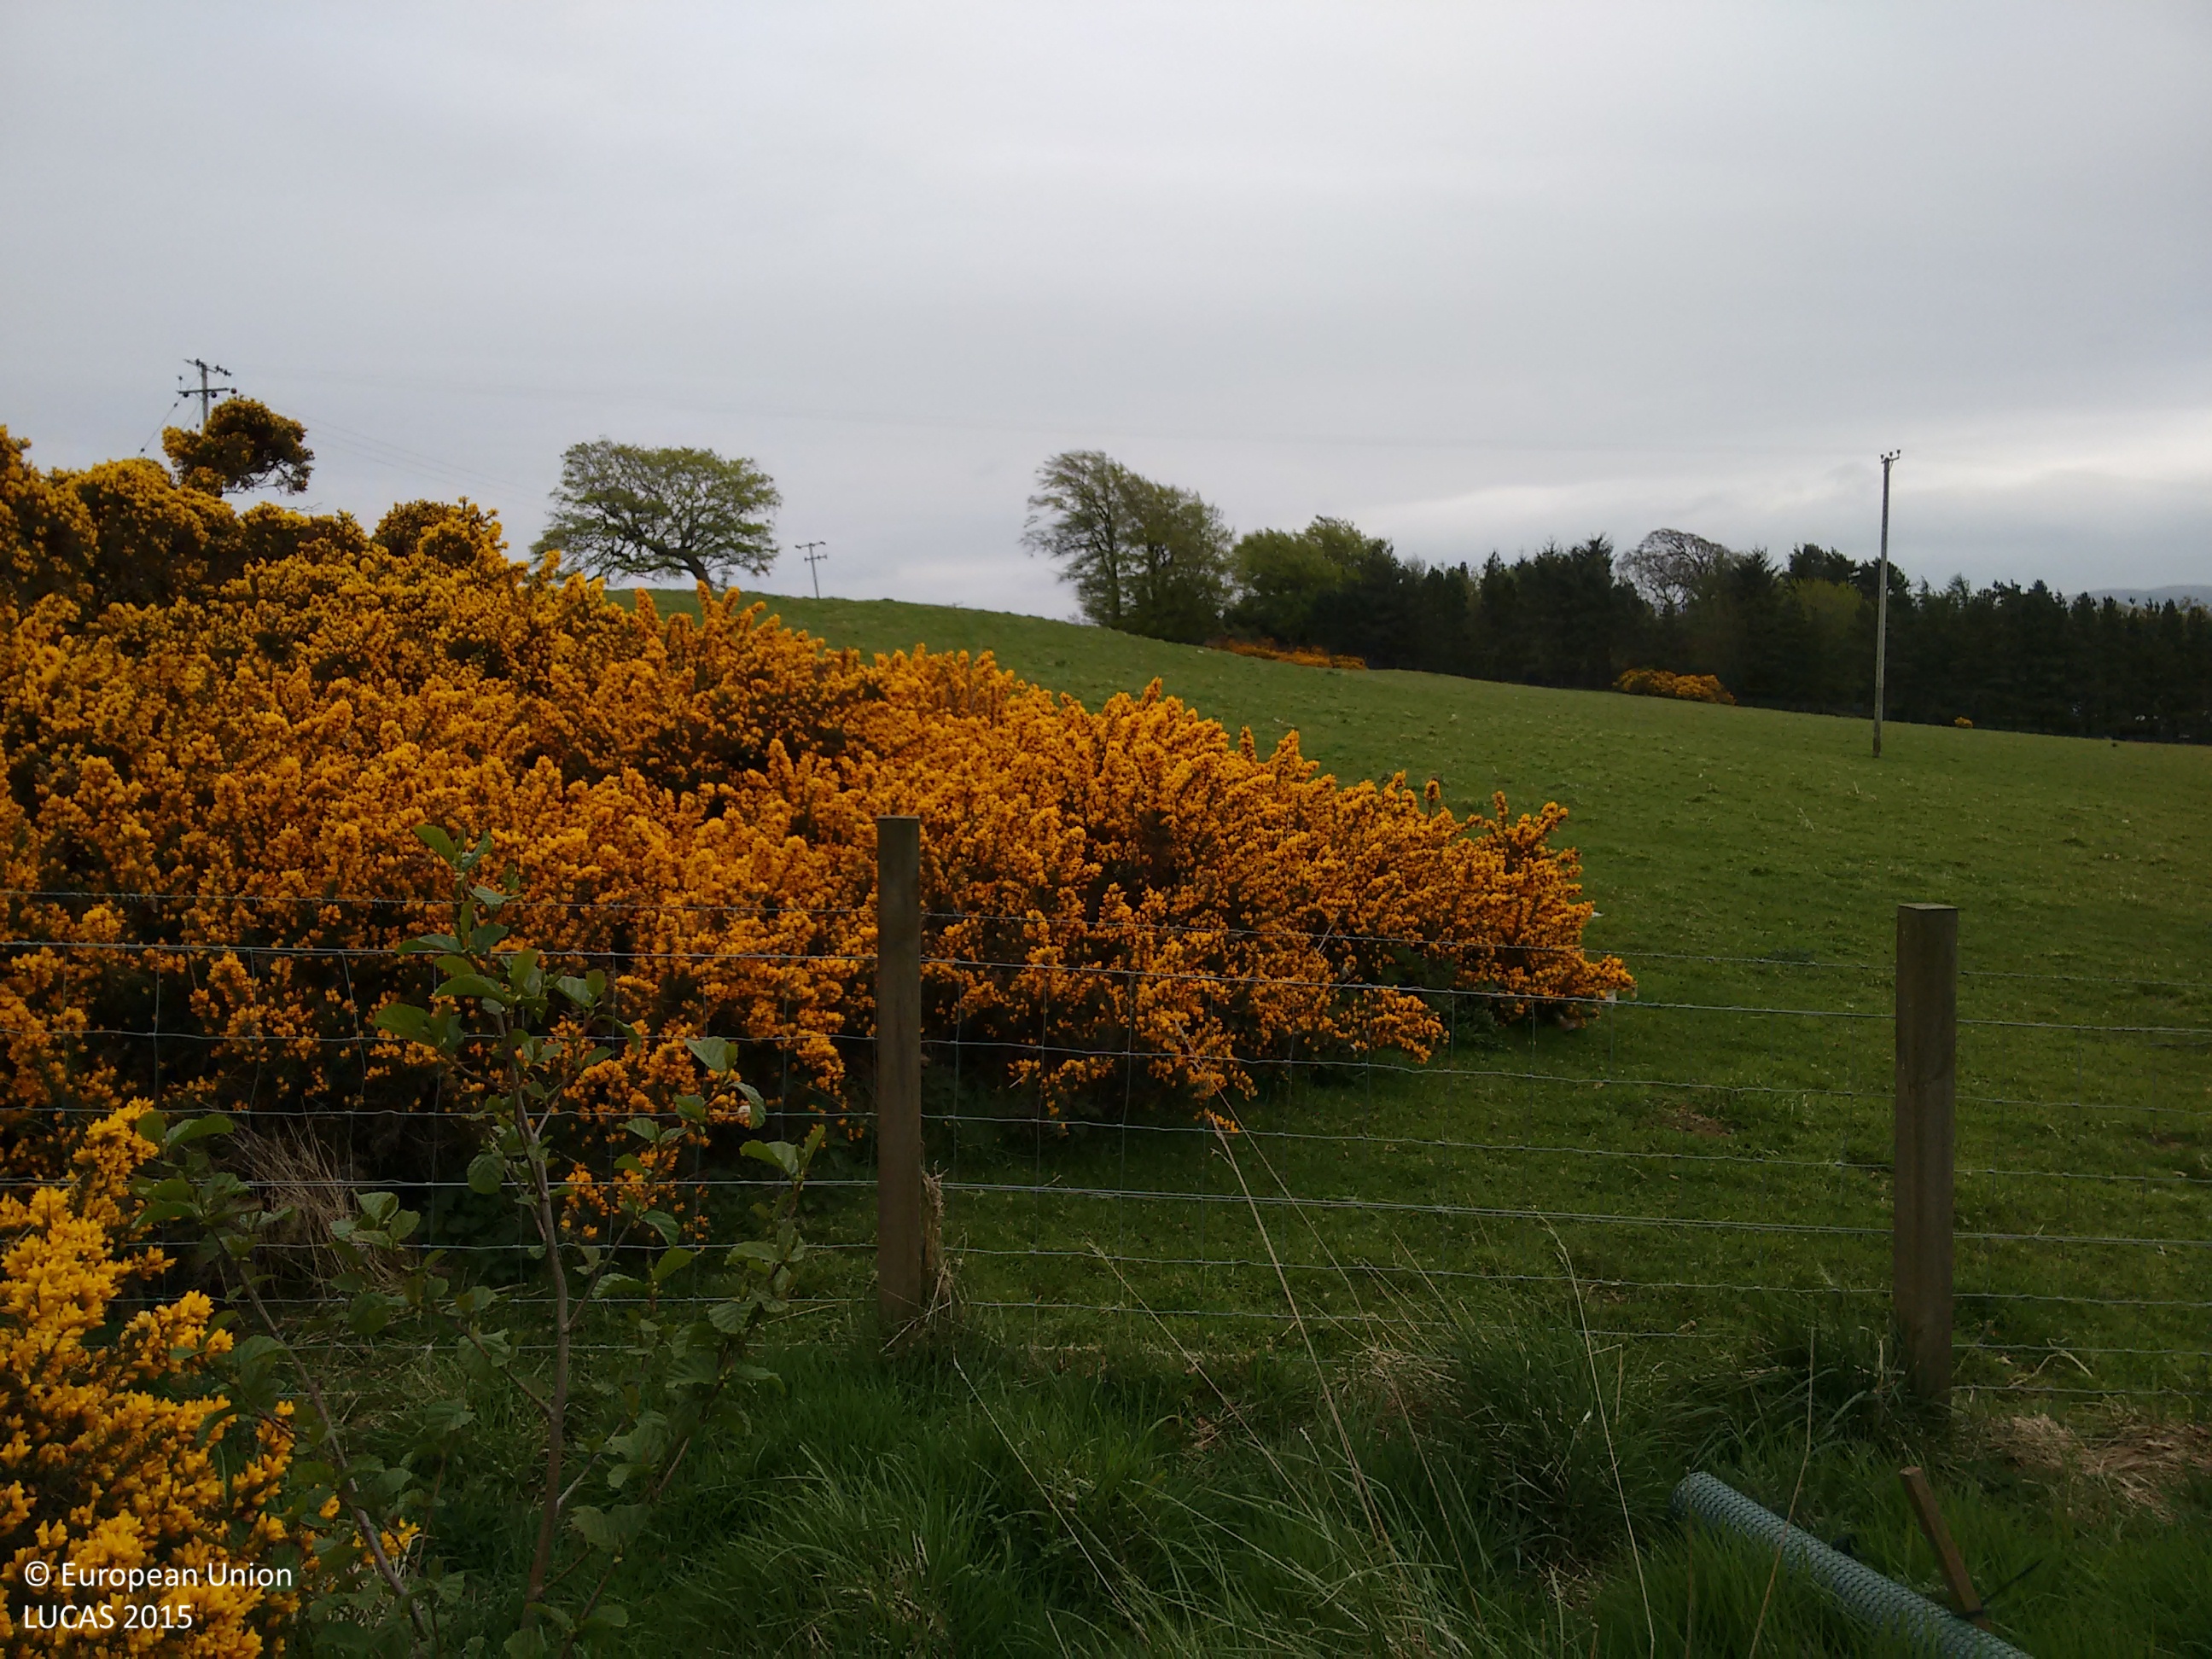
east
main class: Grassland
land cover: Grassland with sparse tree/shrub cover
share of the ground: > 75 %
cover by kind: herbaceous plants 90 %, broadleaved forest trees 5 %, shrubs 5 %
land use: Forestry
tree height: < 5 m
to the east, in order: Grassland with sparse tree/shrub cover; Fences; Grassland without tree/shrub cover; Fences; Other mixed woodland; Fences; Grassland without tree/shrub cover; Fences; Dry stone walls; Shrubland with sparse tree cover; Fences; Artificial constructions in urban areas
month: May
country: GB
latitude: 55.8864
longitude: -3.3608
